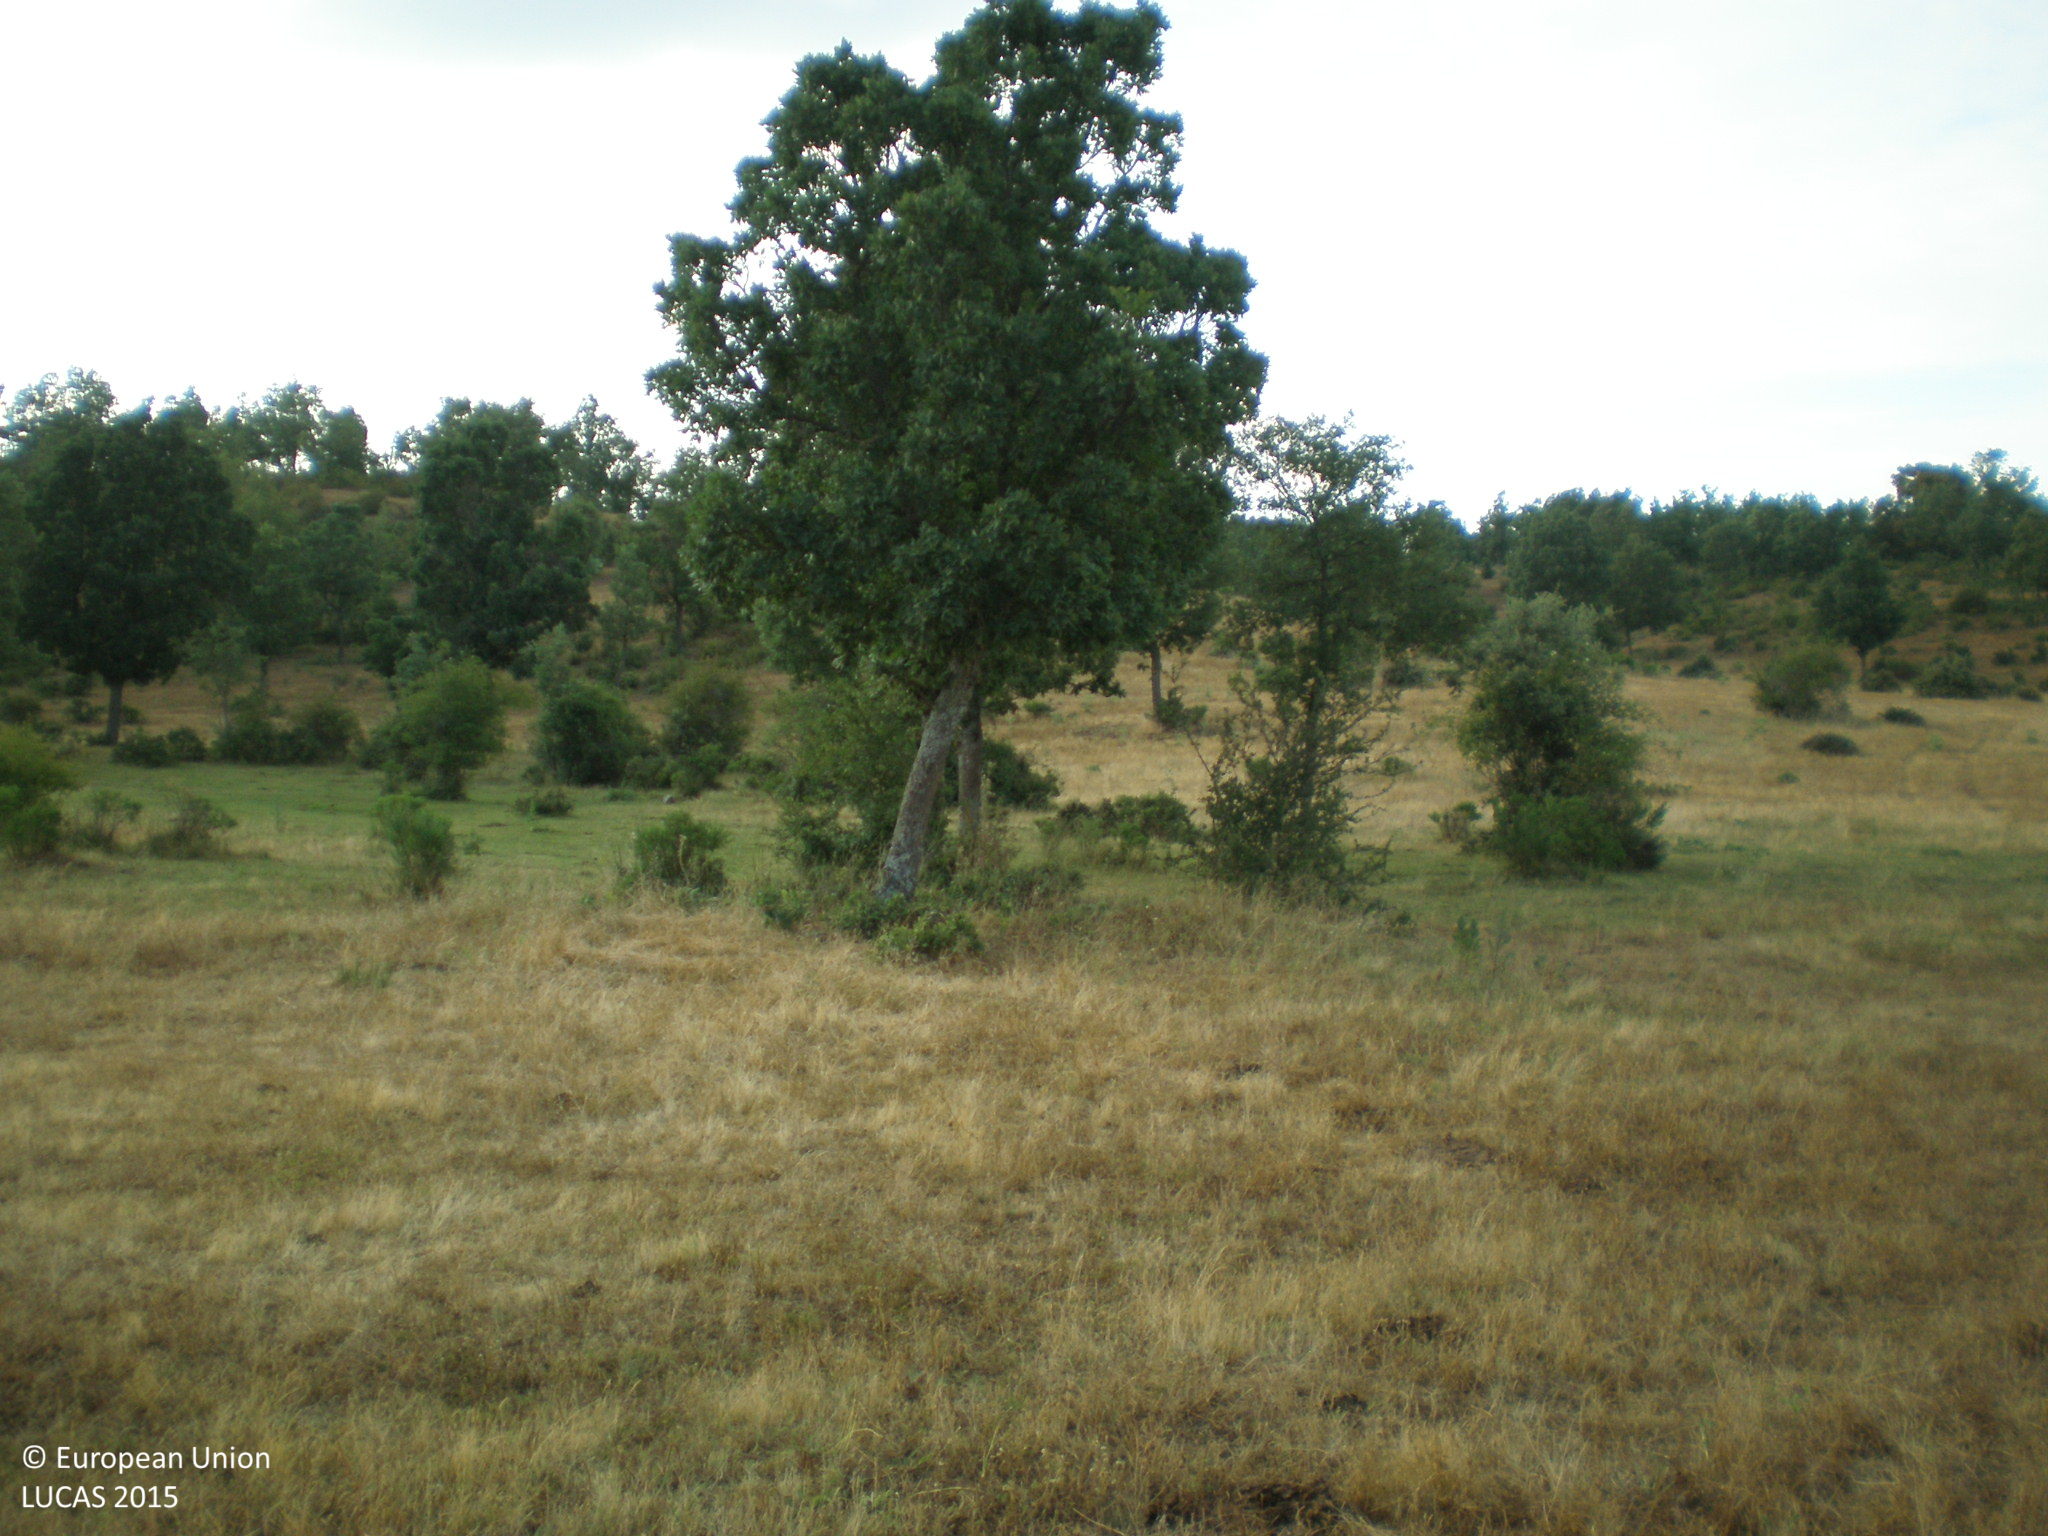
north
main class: Grassland
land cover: Grassland without tree/shrub cover
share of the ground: > 75 %
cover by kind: herbaceous plants 100 %
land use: Agriculture (excluding fallow land and kitchen gardens)
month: June
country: ES
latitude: 41.2082
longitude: -5.7655
